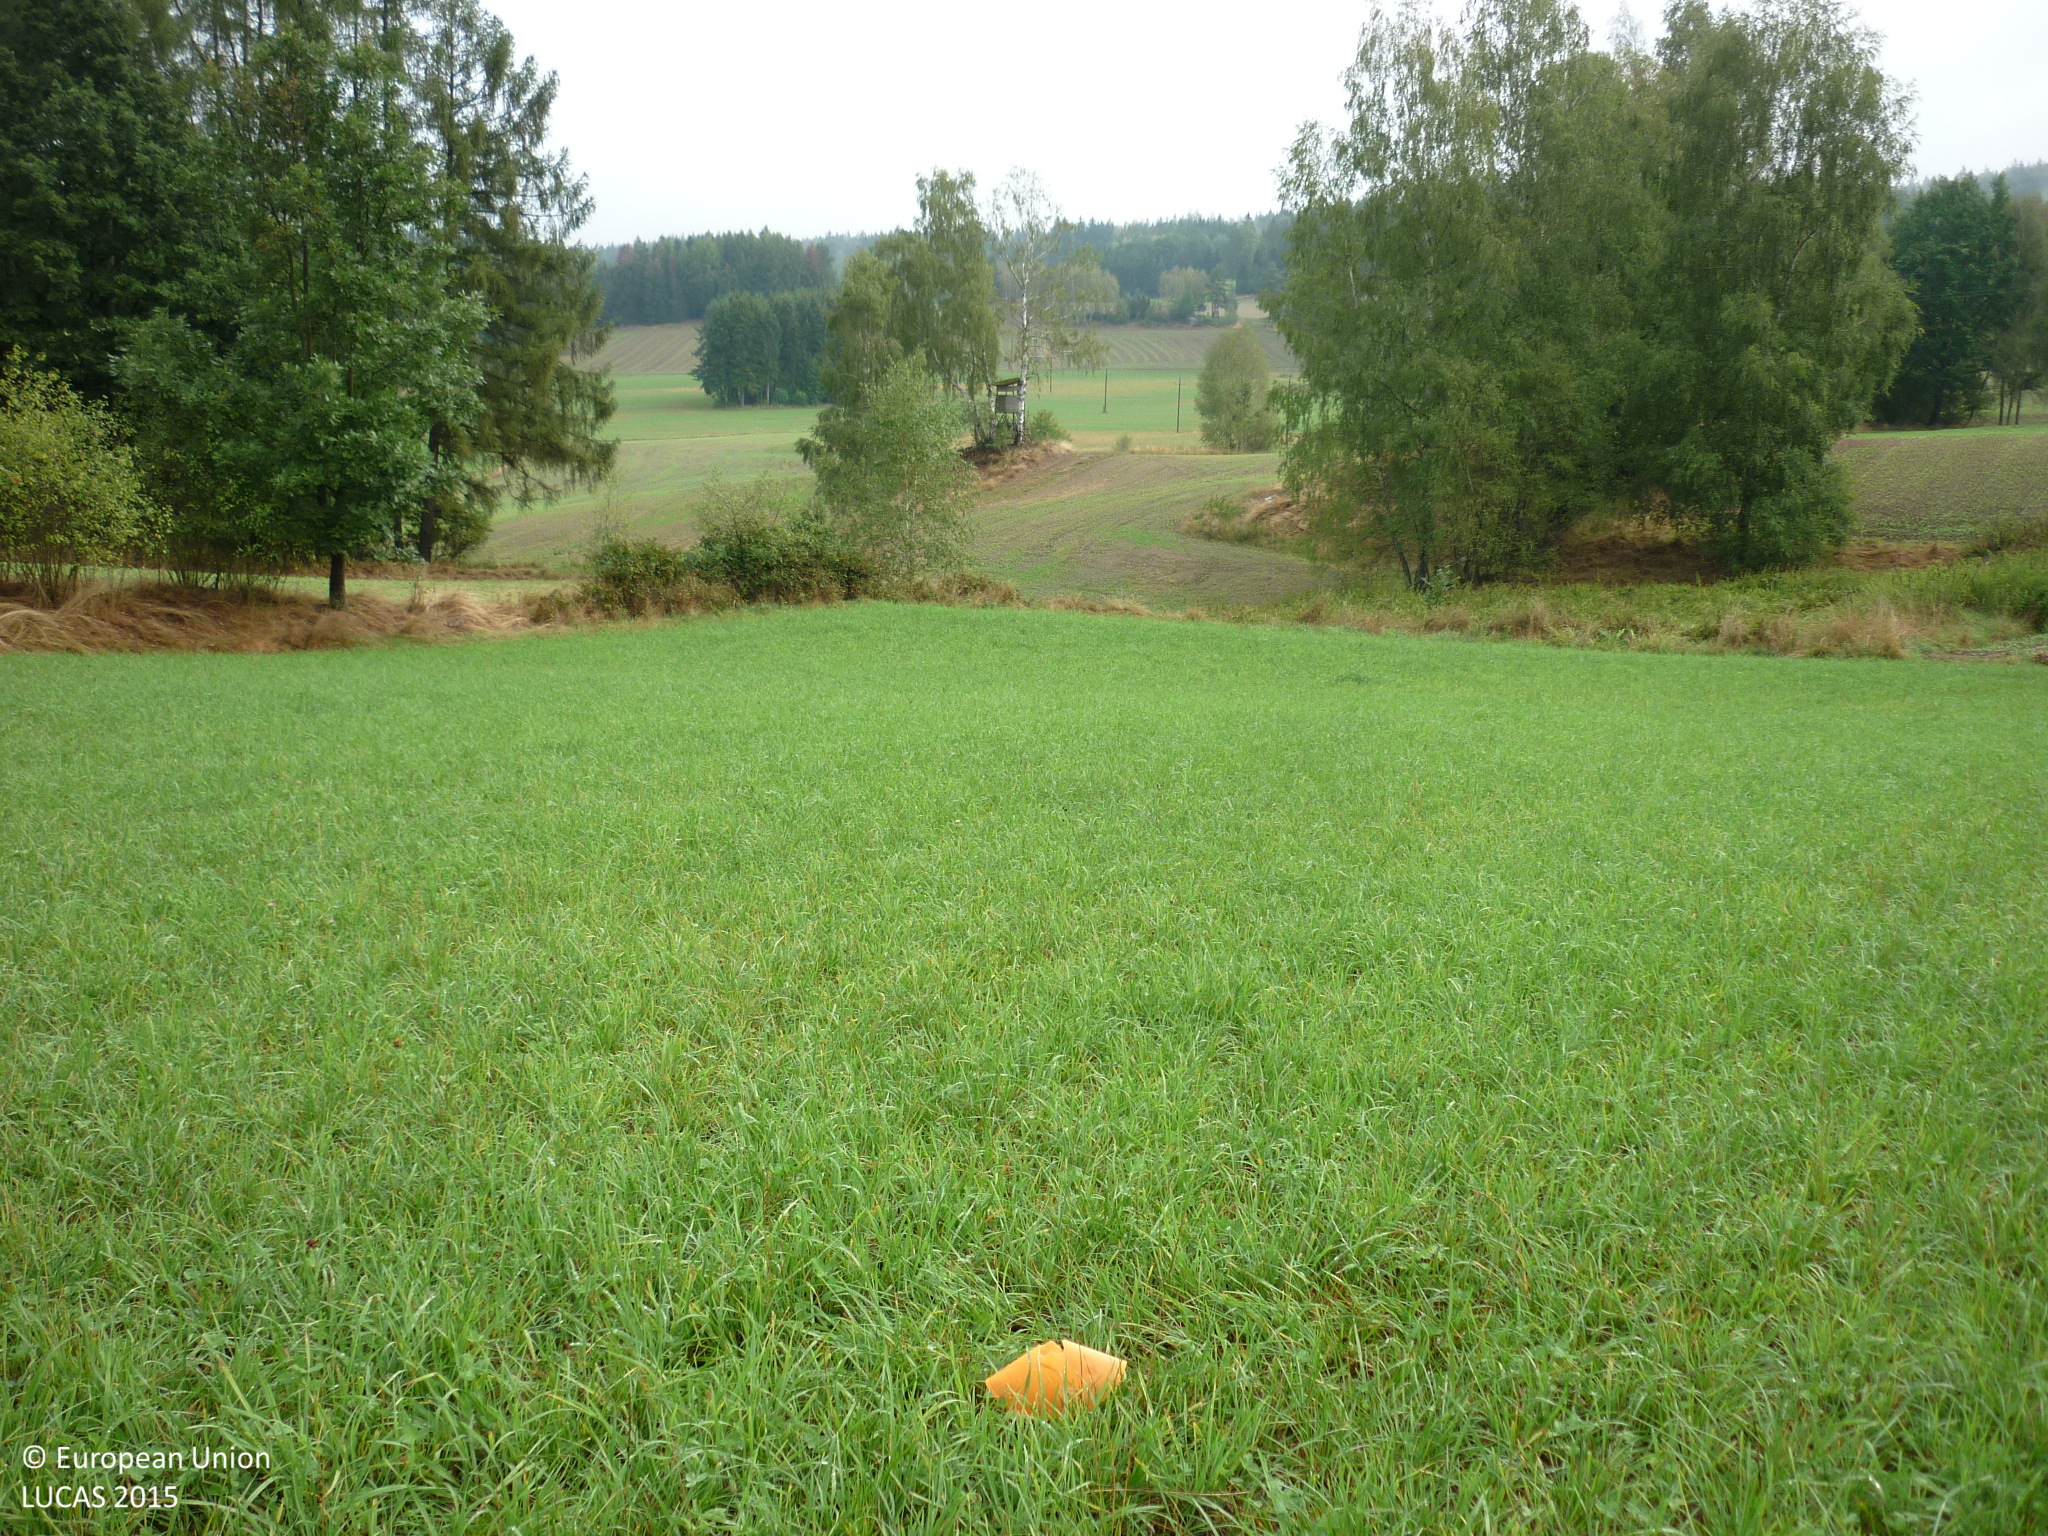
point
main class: Cropland
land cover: Other leguminous and mixtures for fodder
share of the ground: > 75 %
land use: Agriculture (excluding fallow land and kitchen gardens)
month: September
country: AT
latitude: 48.9567
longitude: 15.0142
